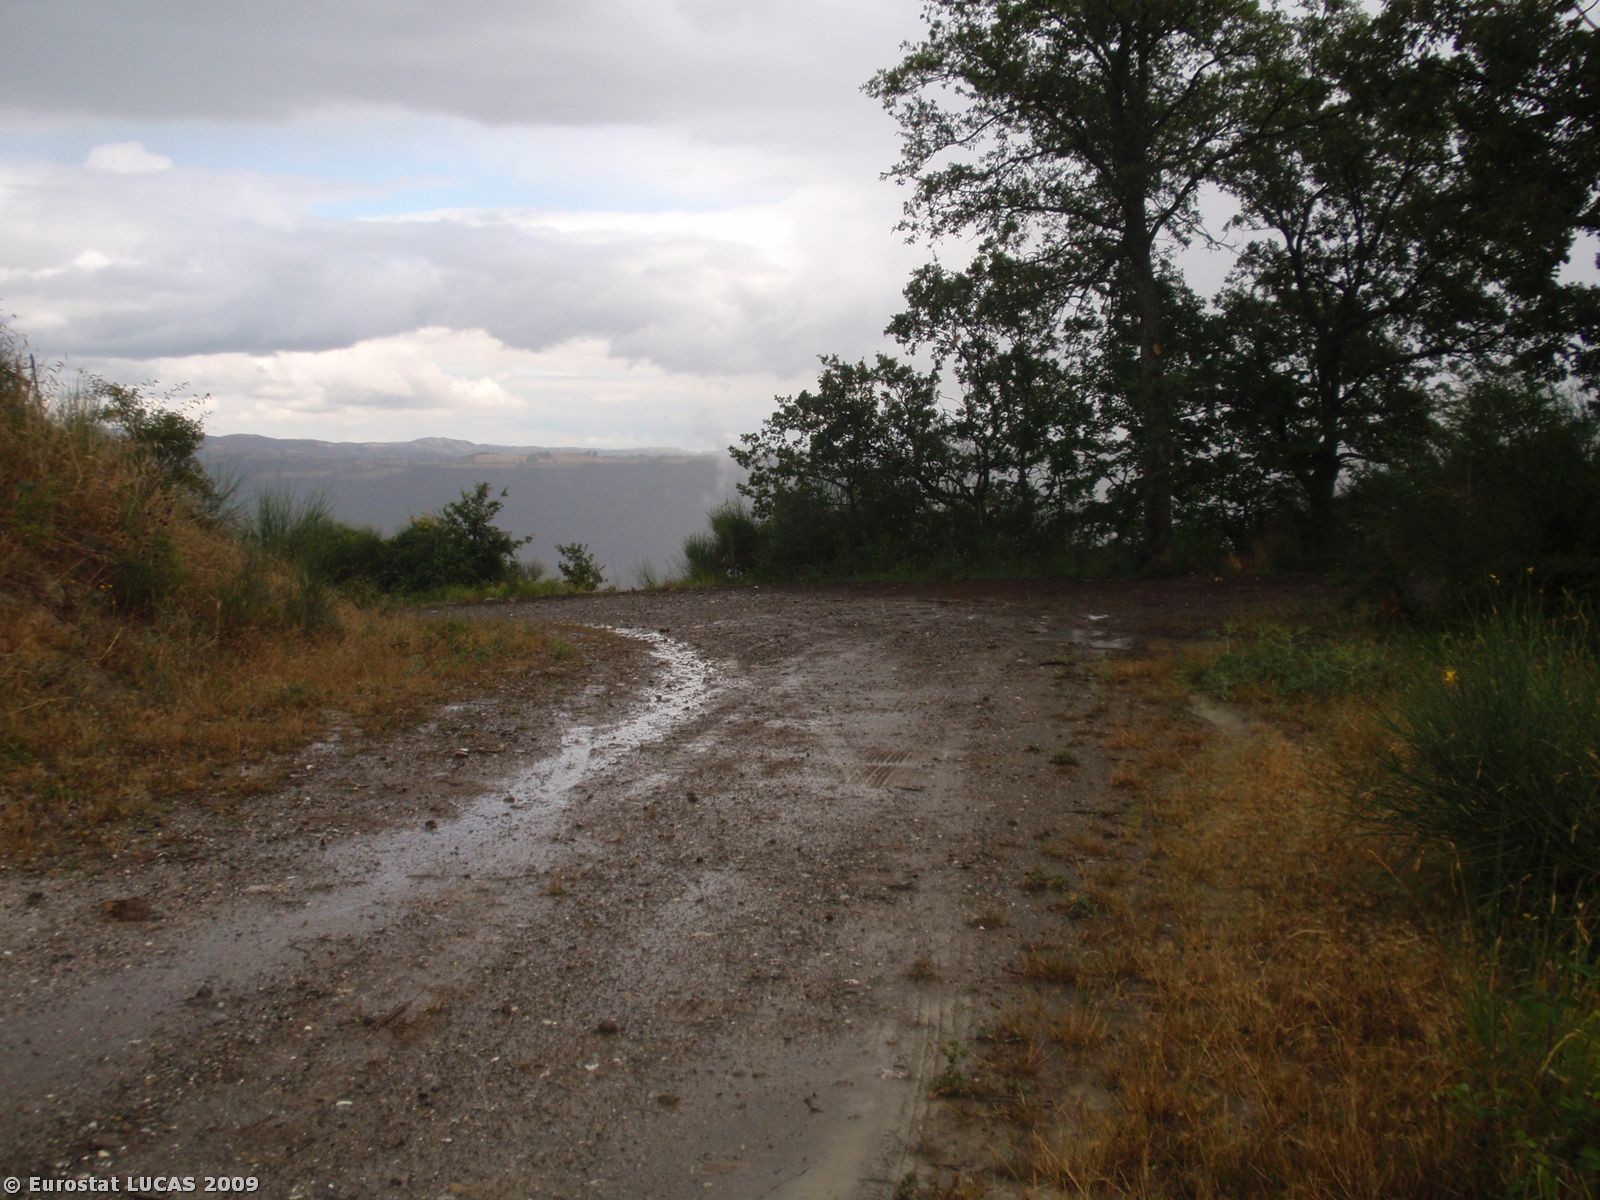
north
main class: Grassland
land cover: Spontaneously vegetated surfaces
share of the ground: > 75 %
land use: Fallow land
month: June
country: IT
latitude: 40.2047
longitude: 16.0958
